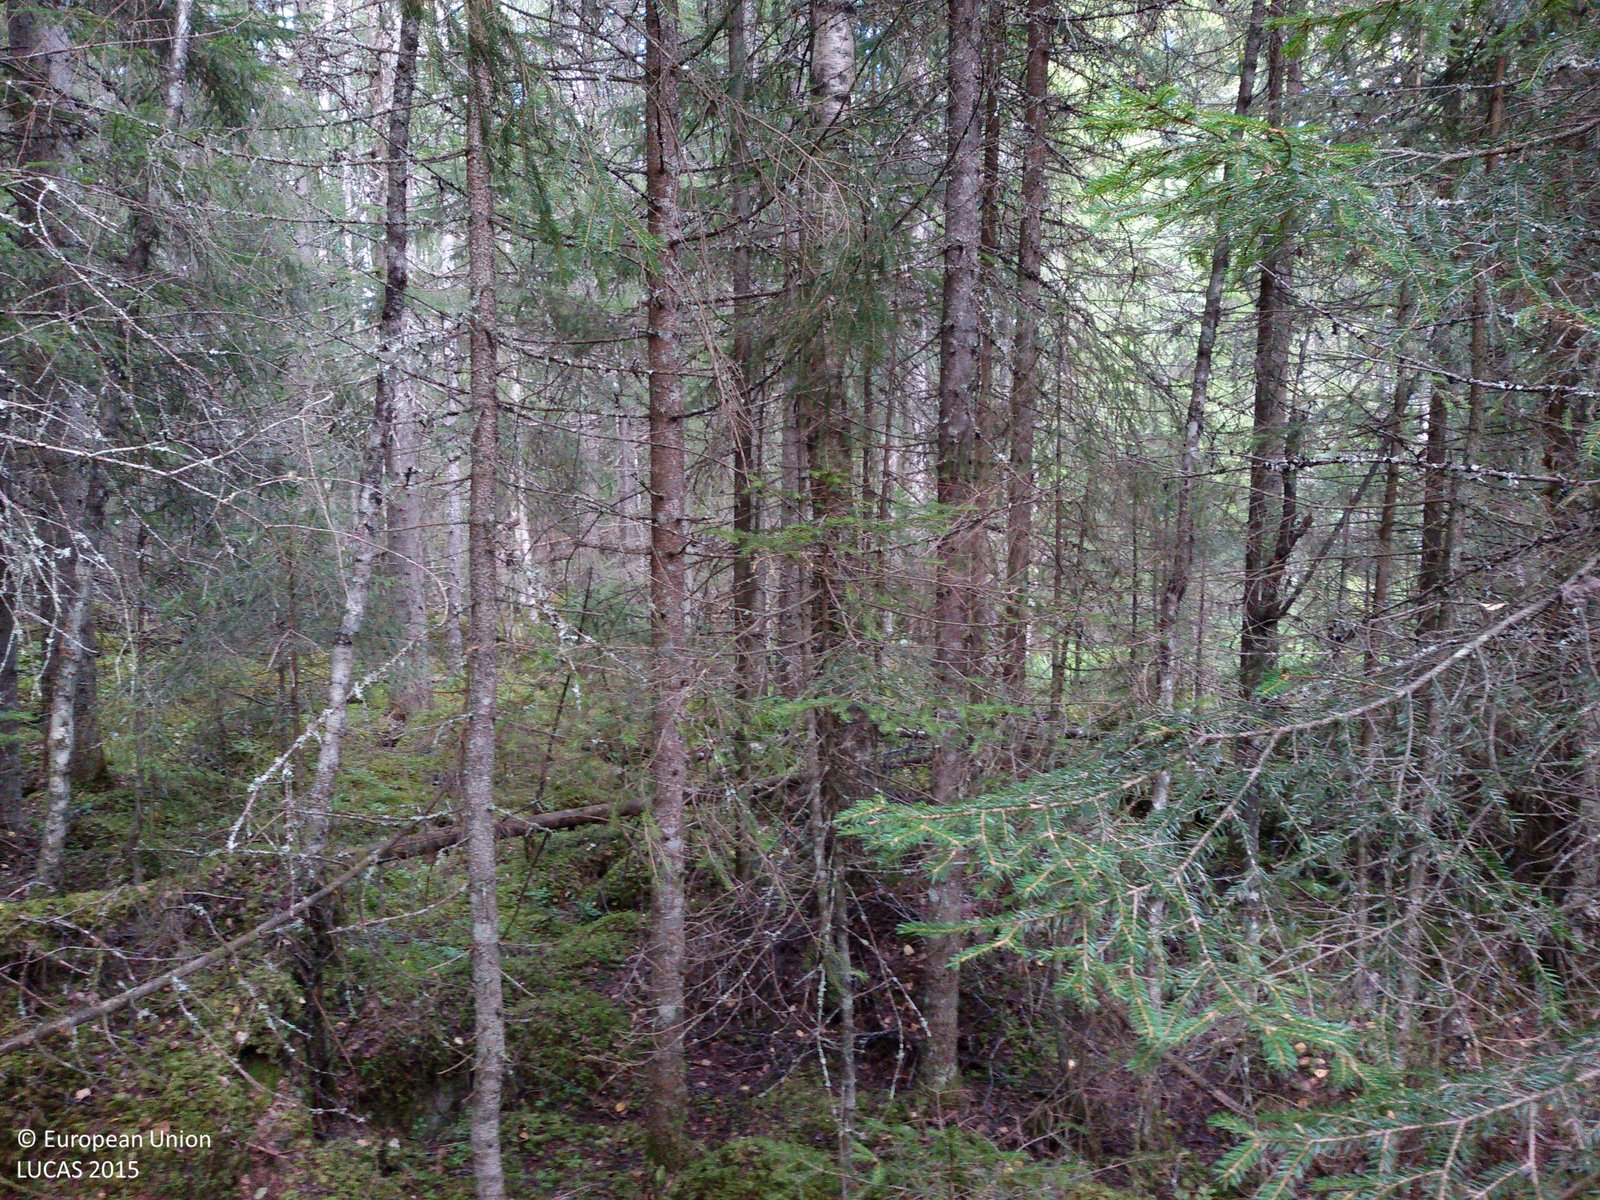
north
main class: Woodland
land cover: Spruce dominated coniferous woodland
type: boreal forest
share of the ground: > 75 %
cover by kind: coniferous forest trees 90 %, lichens and mosses 10 %
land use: Forestry
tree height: > 5 m
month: September
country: SE
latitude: 60.9454
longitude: 15.3577
